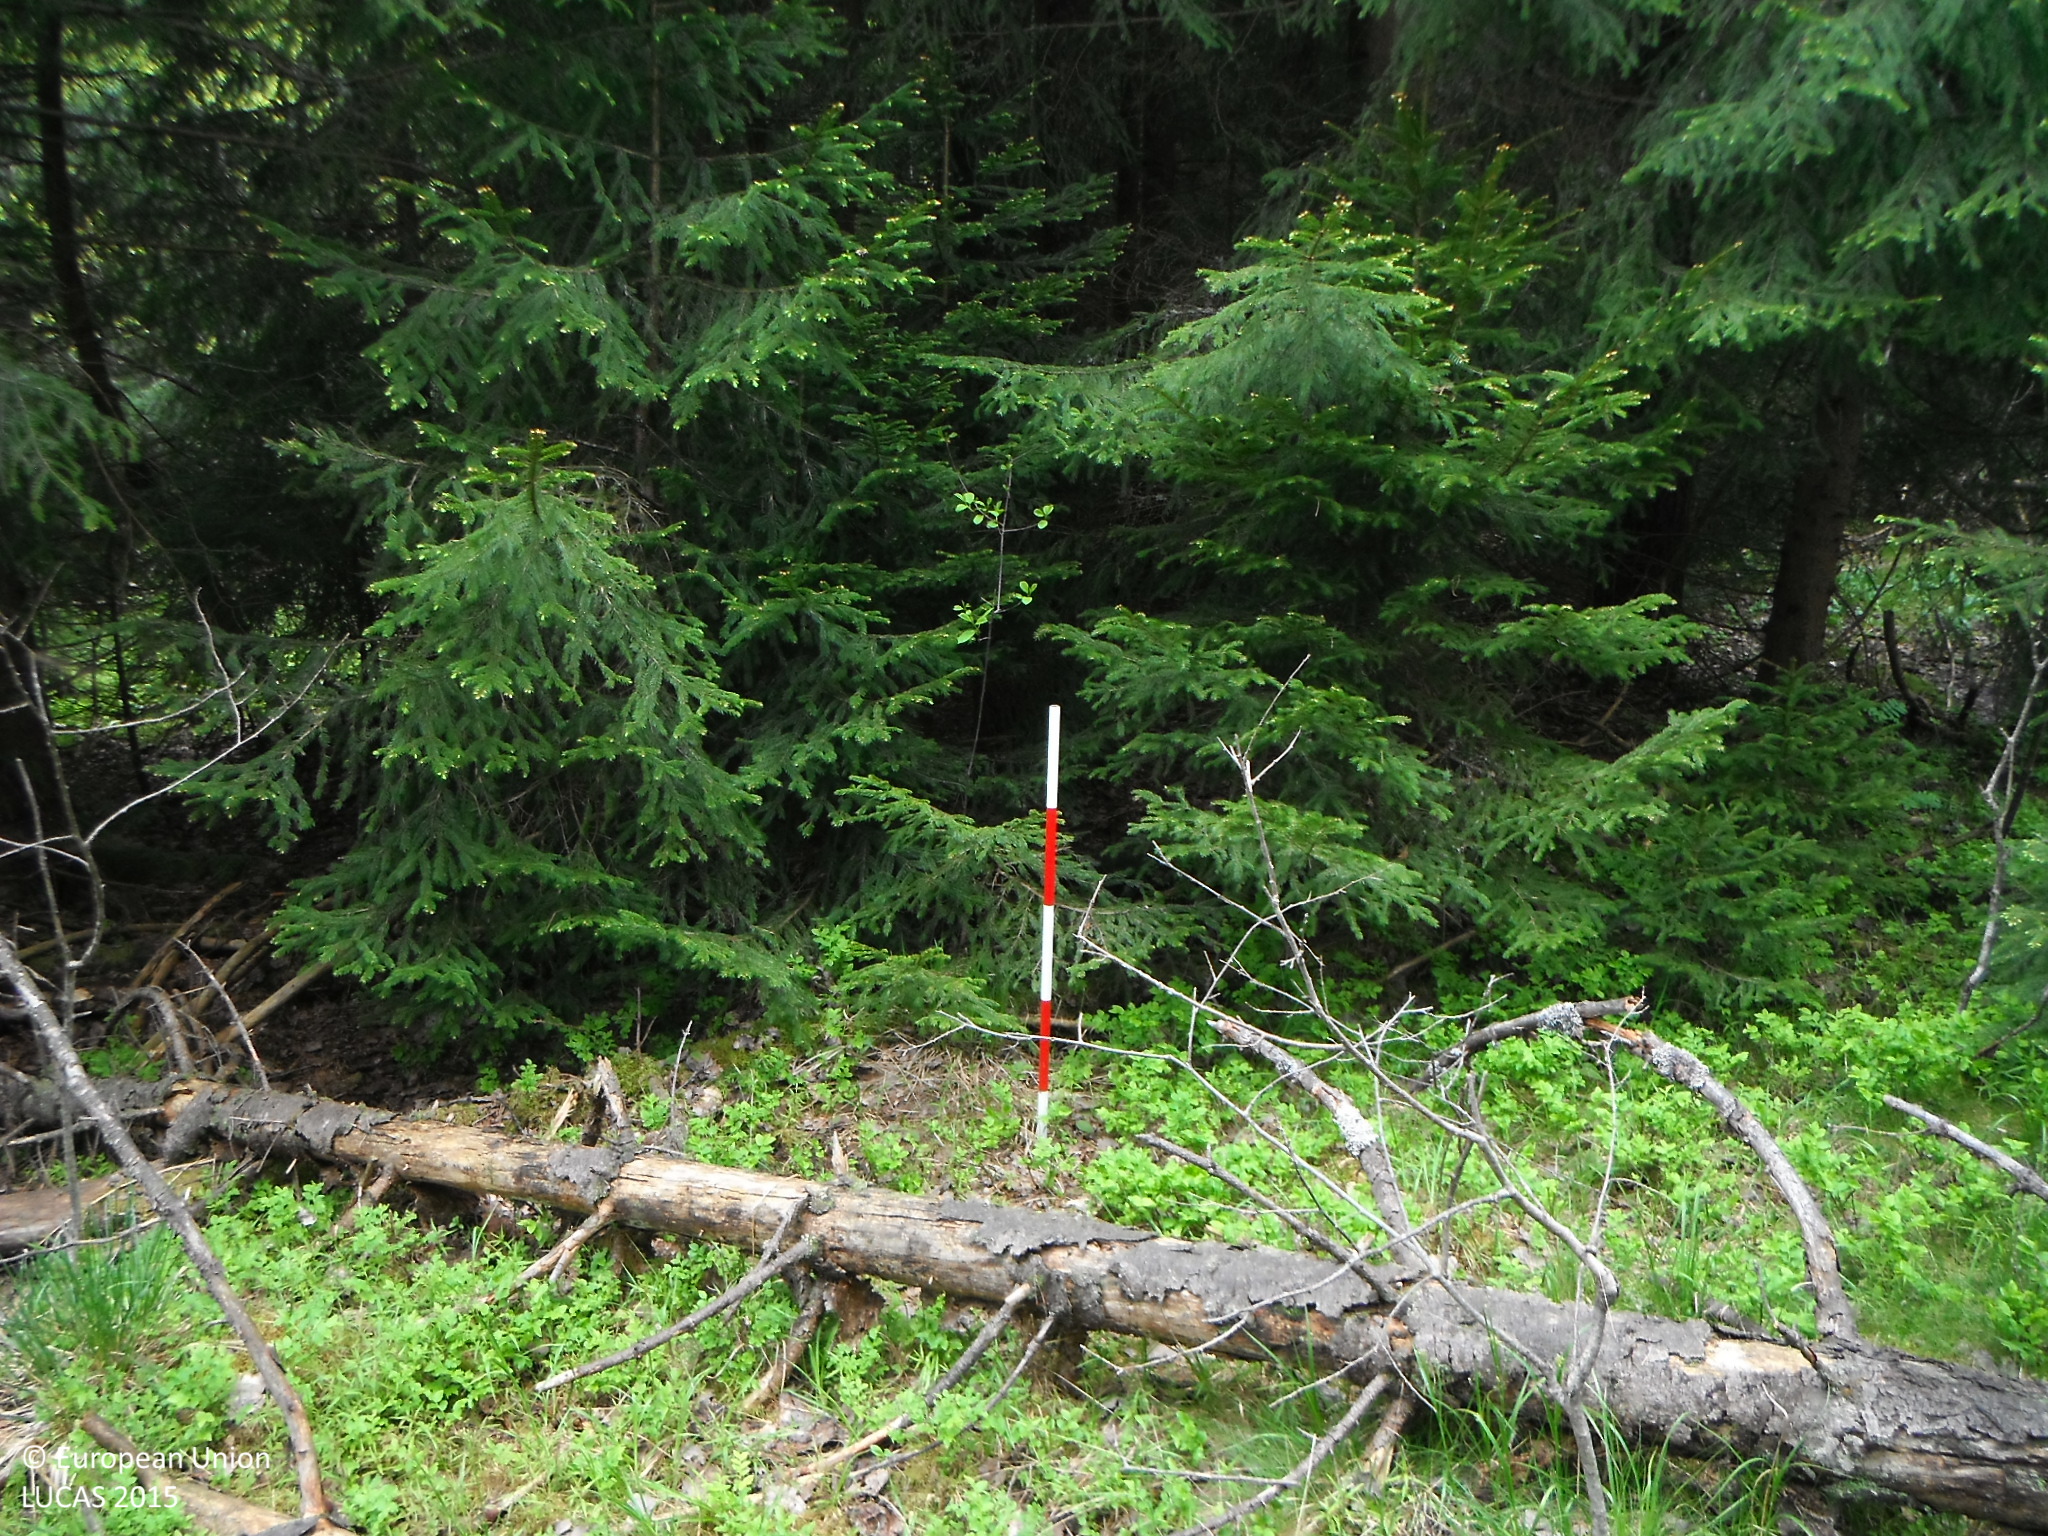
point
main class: Woodland
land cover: Spruce dominated coniferous woodland
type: alpine coniferous forest
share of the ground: > 75 %
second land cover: Spontaneously vegetated surfaces
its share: 25 - 50 %
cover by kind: coniferous forest trees 75 %, herbaceous plants 25 %
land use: Forestry
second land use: Agriculture (excluding fallow land and kitchen gardens)
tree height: > 5 m
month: June
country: SK
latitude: 49.1116
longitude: 19.7690
